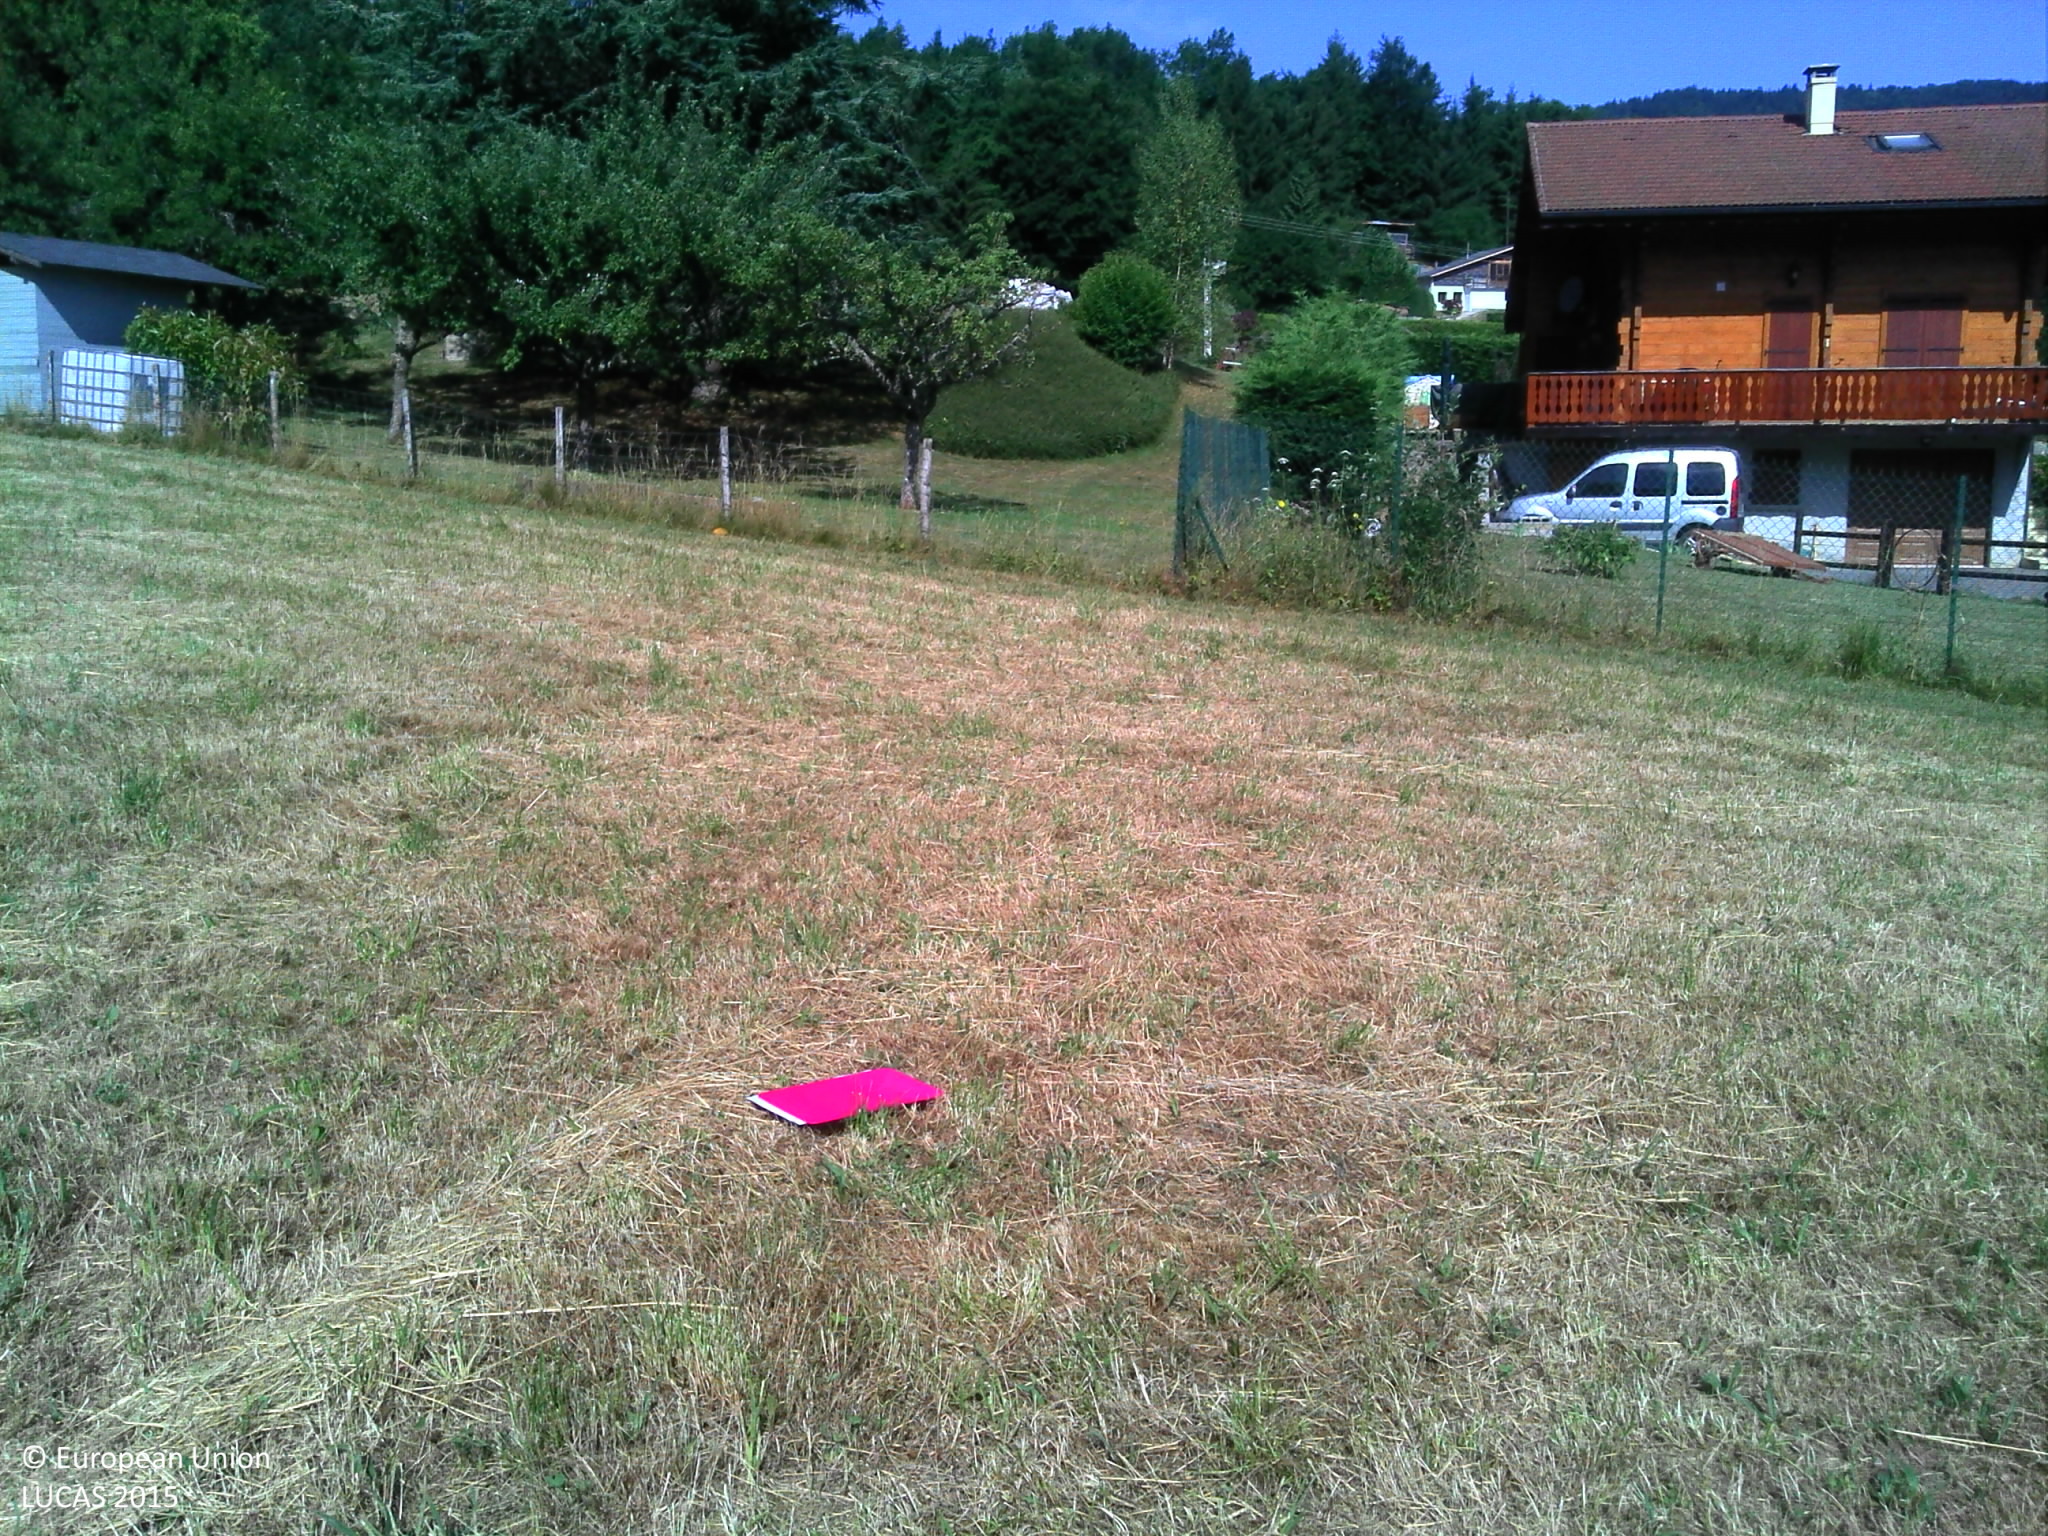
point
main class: Grassland
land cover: Grassland without tree/shrub cover
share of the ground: > 75 %
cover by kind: herbaceous plants 100 %
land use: Agriculture (excluding fallow land and kitchen gardens)
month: July
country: FR
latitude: 46.1821
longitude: 6.3891
